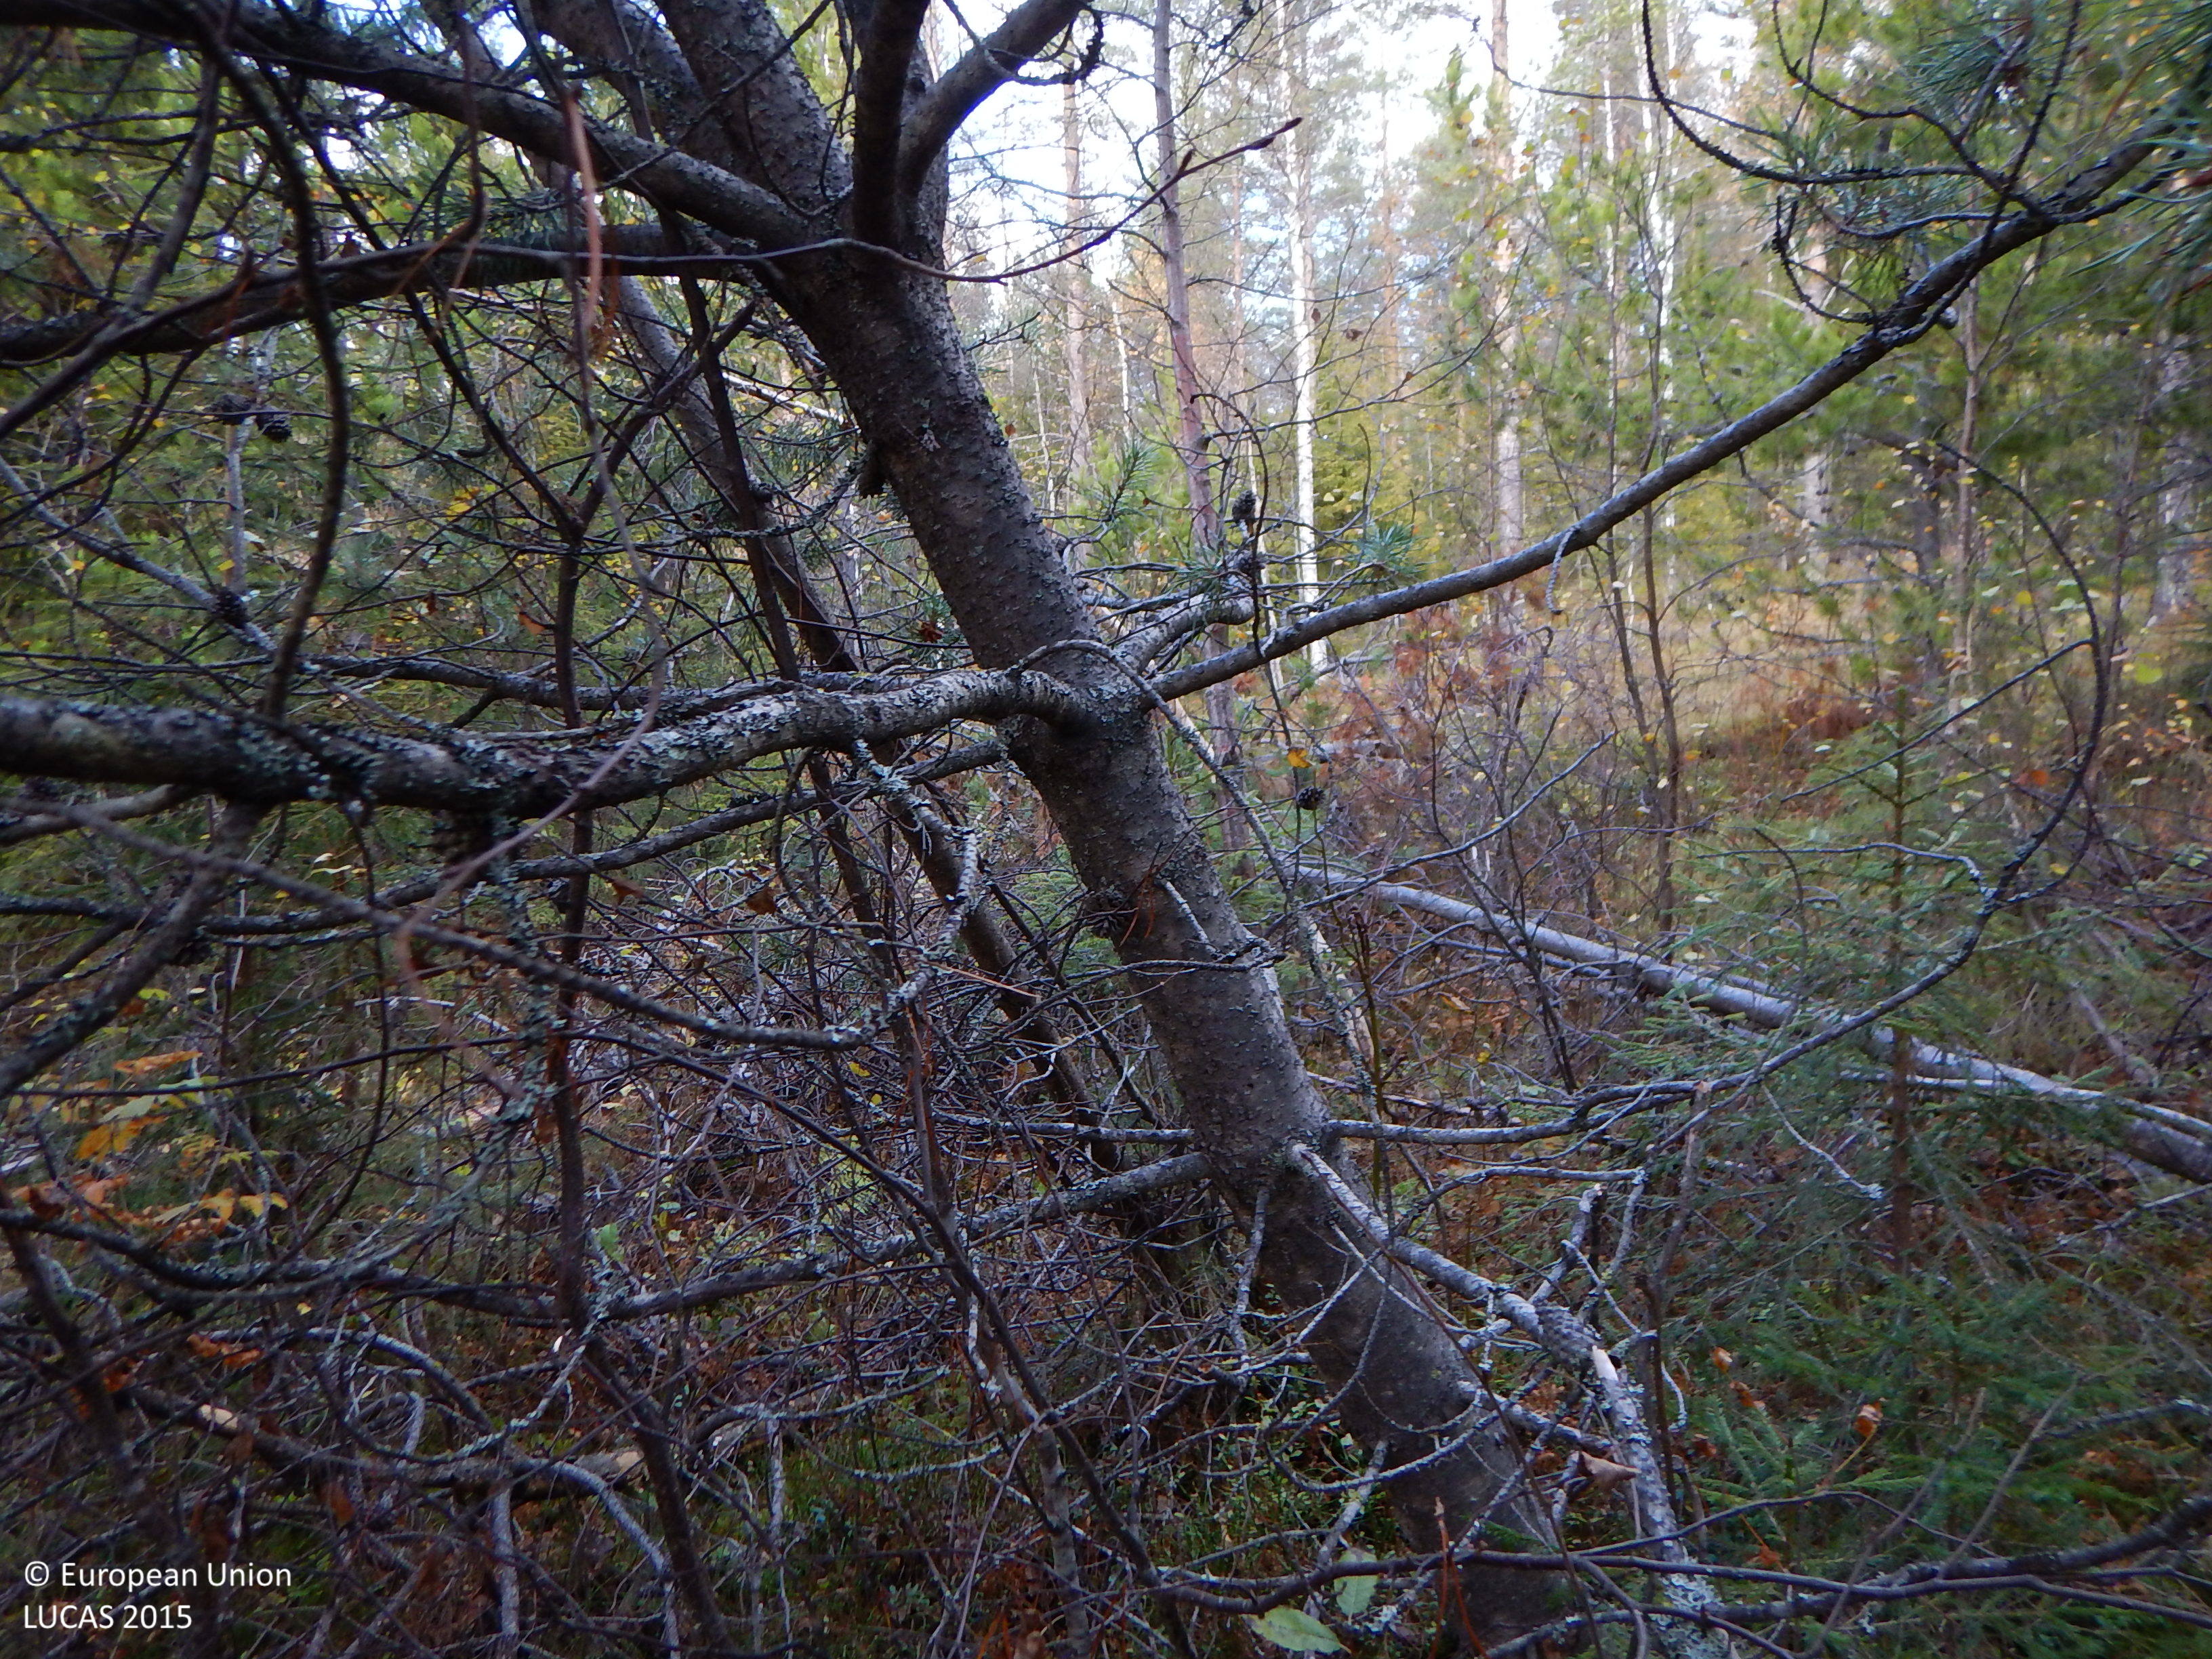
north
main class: Woodland
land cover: Pine dominated coniferous woodland
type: exotic forest
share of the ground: > 75 %
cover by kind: coniferous forest trees 75 %, shrubs 10 %, broadleaved forest trees 5 %, herbaceous plants 5 %, lichens and mosses 5 %
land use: Forestry
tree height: > 5 m
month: October
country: SE
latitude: 65.0868
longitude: 20.5456
